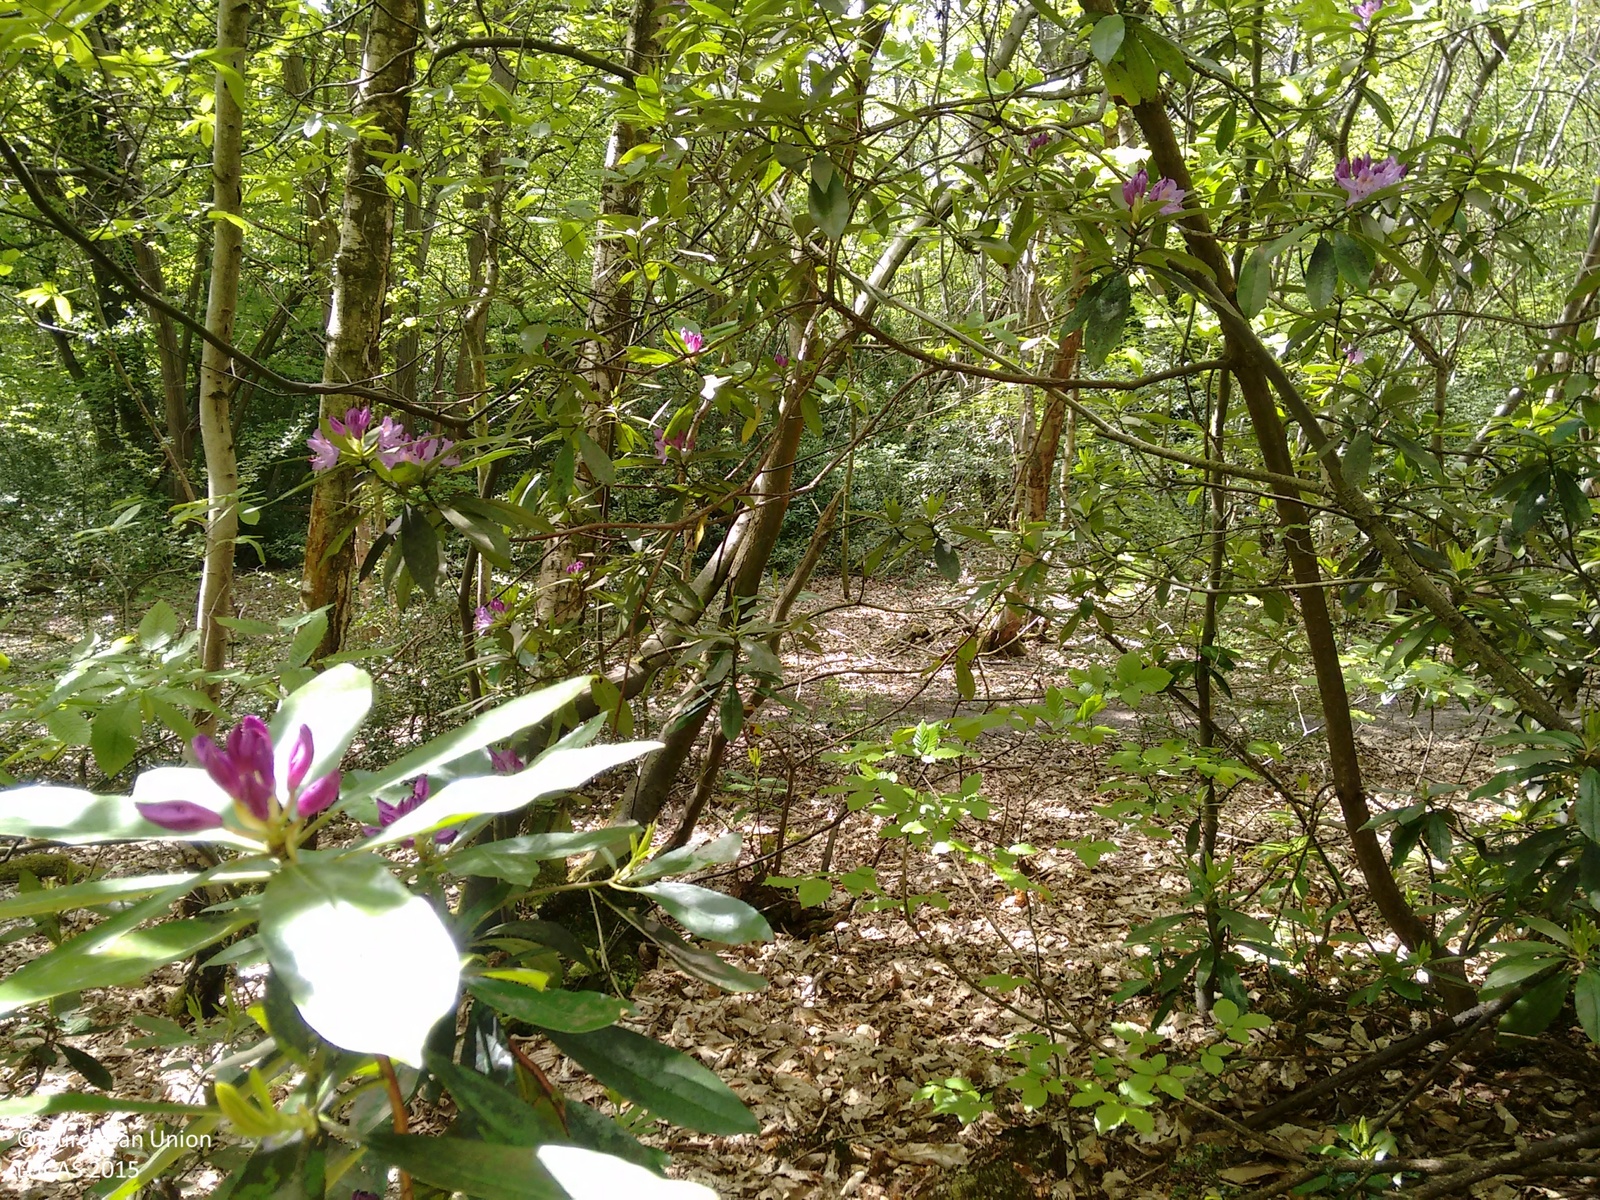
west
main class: Woodland
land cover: Broadleaved woodland
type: exotic forest
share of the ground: > 75 %
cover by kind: broadleaved forest trees 50 %, shrubs 50 %
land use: Amenities, museums, leisure
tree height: > 5 m
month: May
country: GB
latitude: 51.1457
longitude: 0.2927
